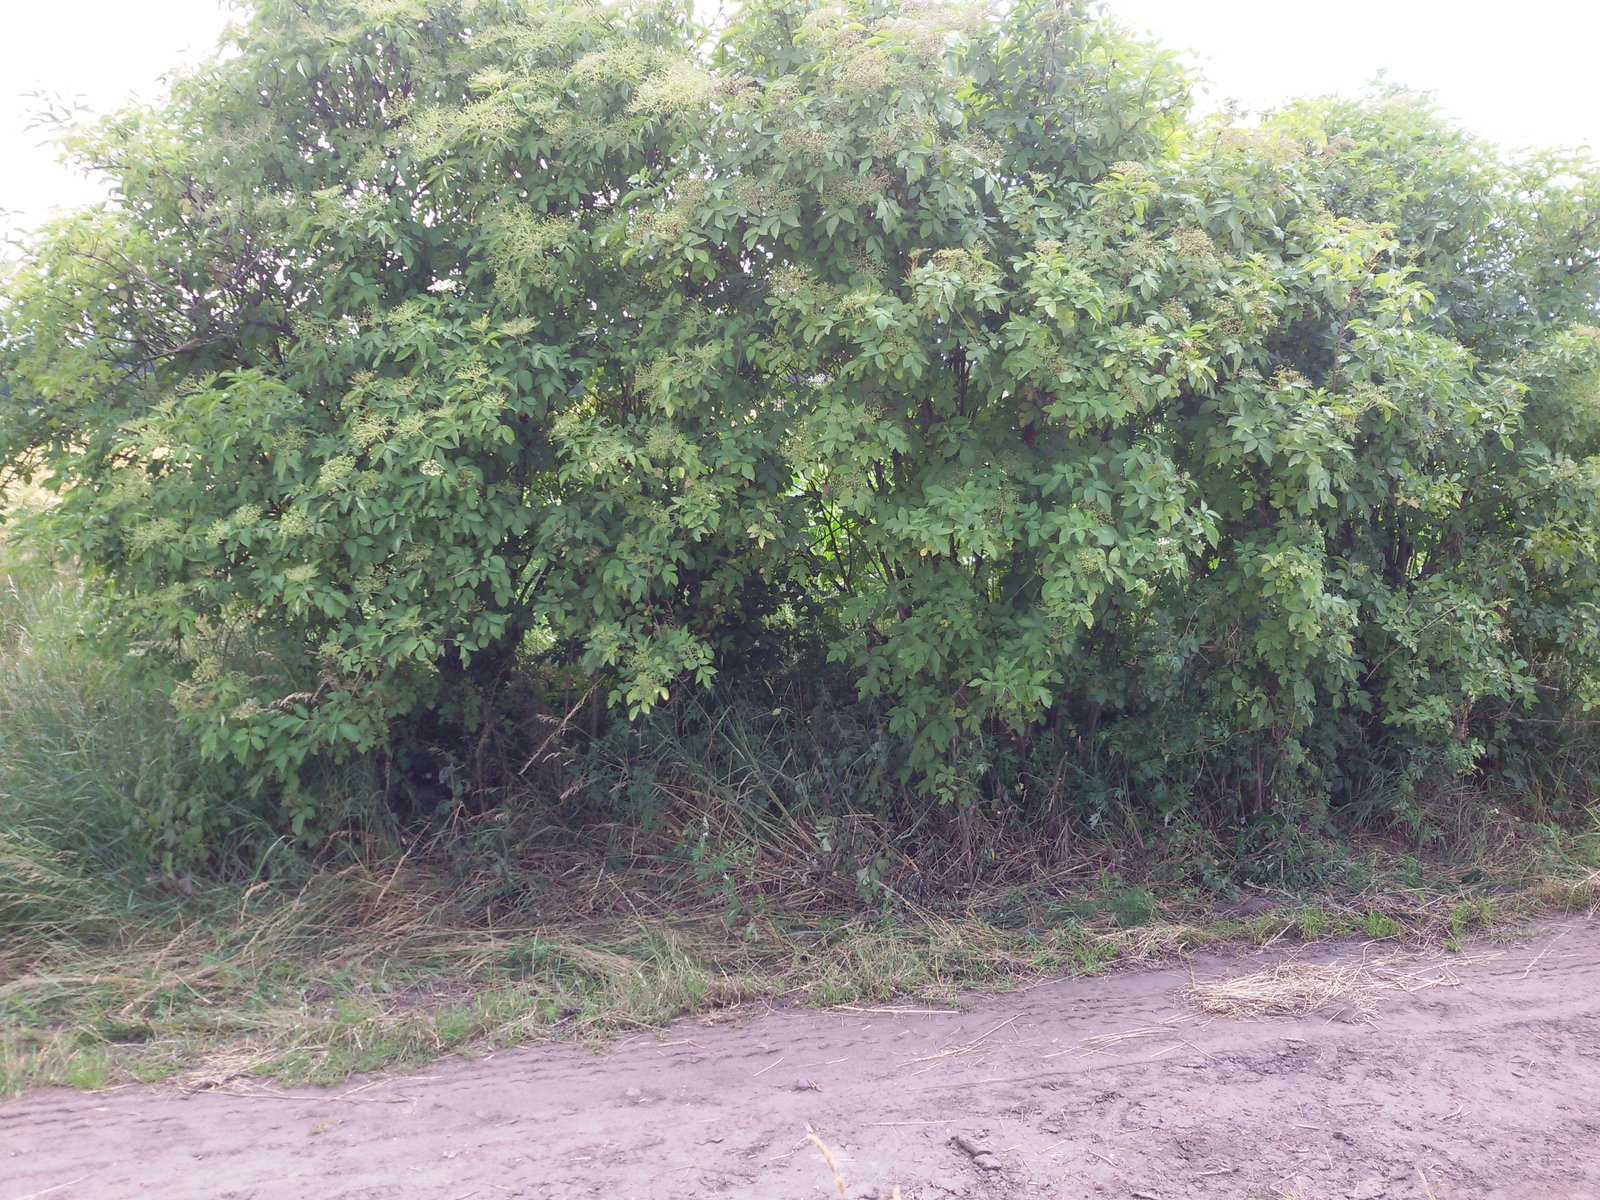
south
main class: Cropland
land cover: Barley
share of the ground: > 75 %
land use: Agriculture (excluding fallow land and kitchen gardens)
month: June
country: PL
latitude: 52.0176
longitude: 16.8433
